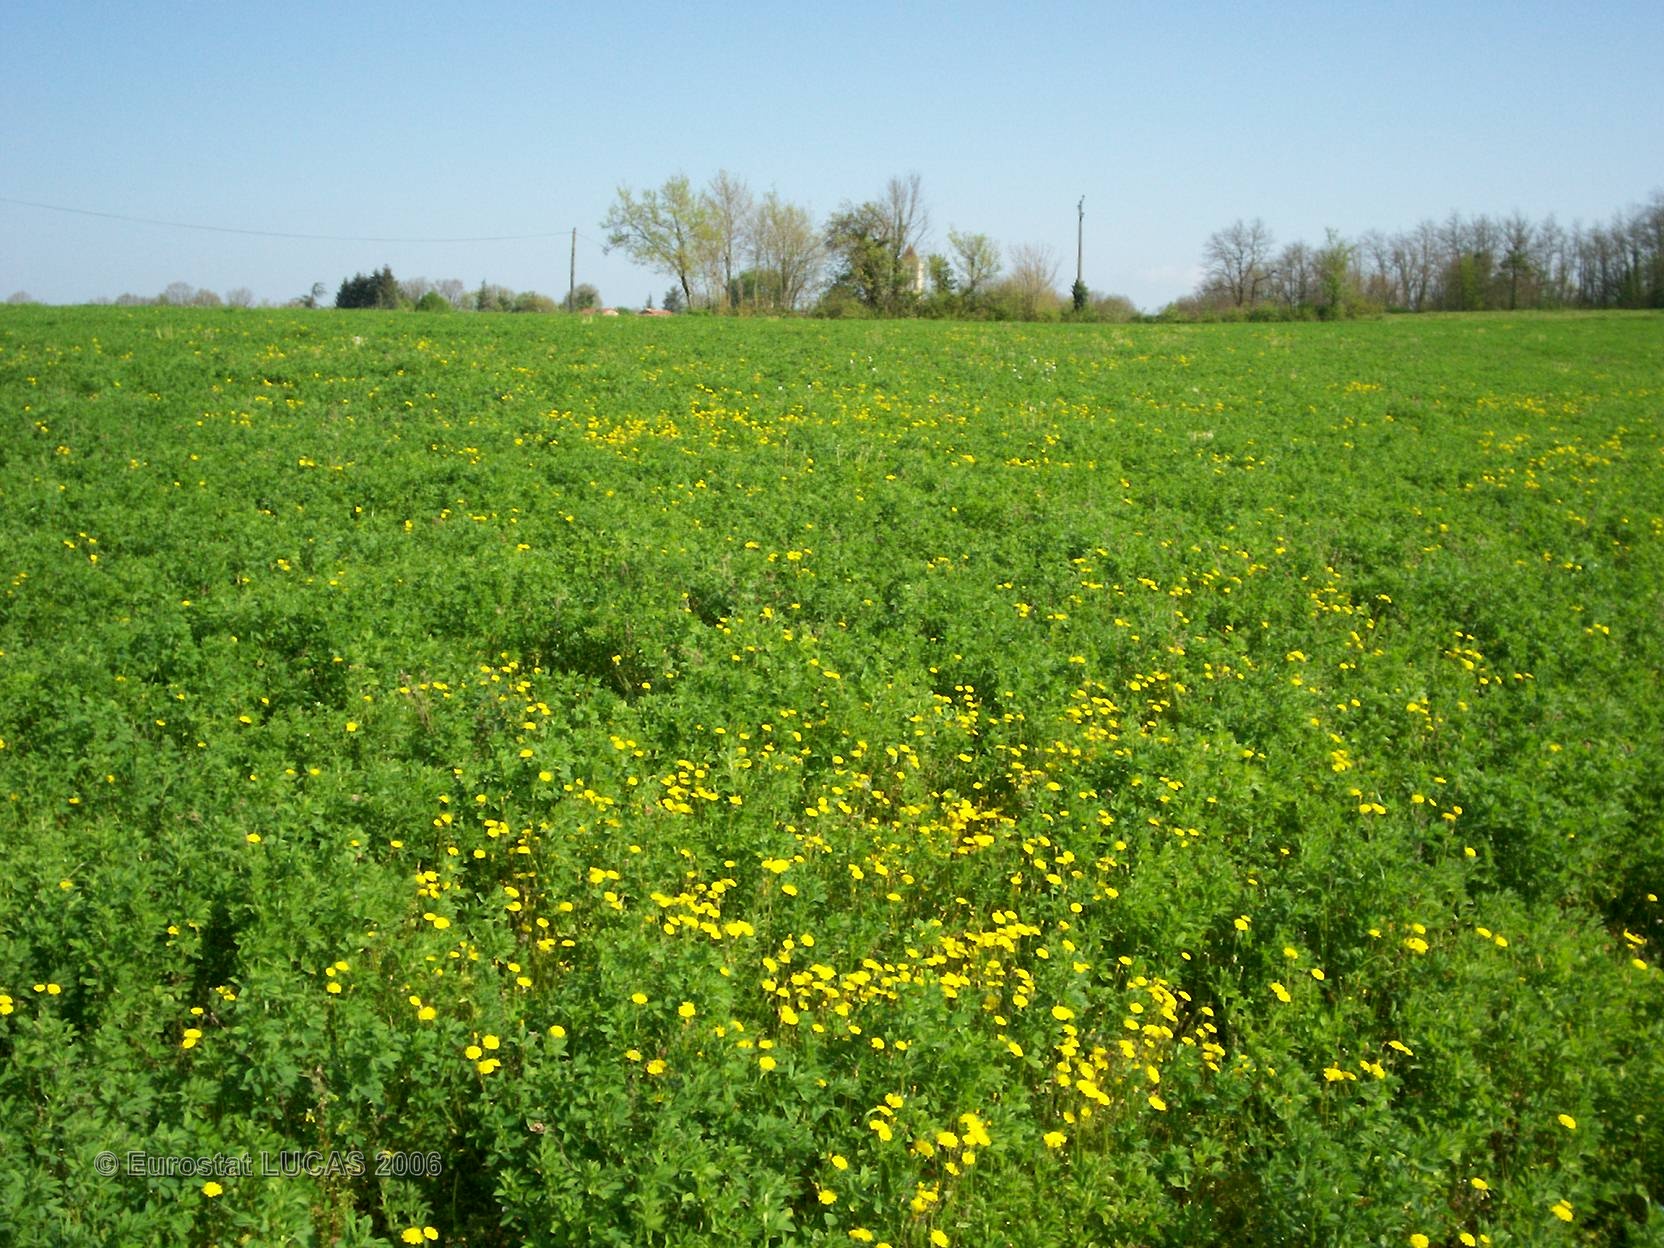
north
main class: Cropland
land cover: Lucerne
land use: Agriculture (excluding fallow land and kitchen gardens)
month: April
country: FR
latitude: 45.5665
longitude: 0.5182
